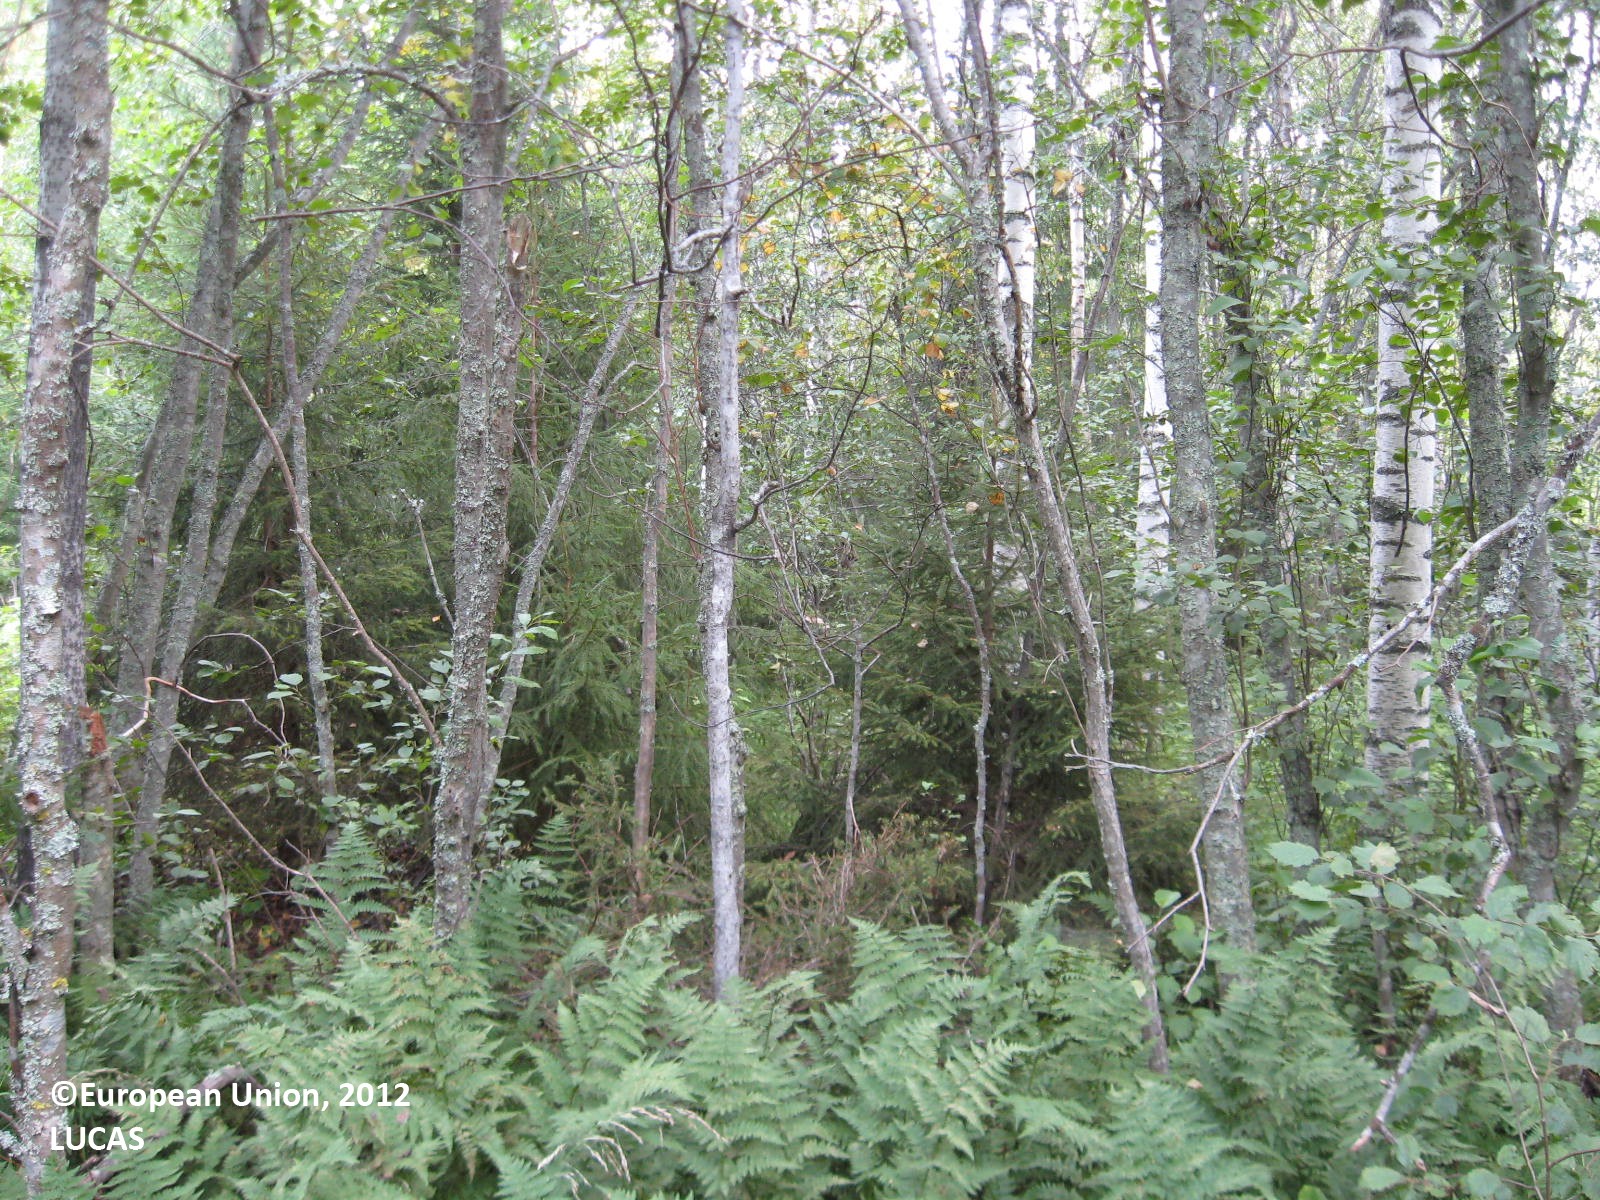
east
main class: Woodland
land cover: Broadleaved woodland
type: boreal forest
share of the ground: 50 - 75 %
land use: Forestry
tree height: > 5 m
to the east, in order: Broadleaved woodland; Pine dominated mixed woodland; Other mixed woodland; Grassland without tree/shrub cover
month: August
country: FI
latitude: 63.4168
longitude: 29.6010
